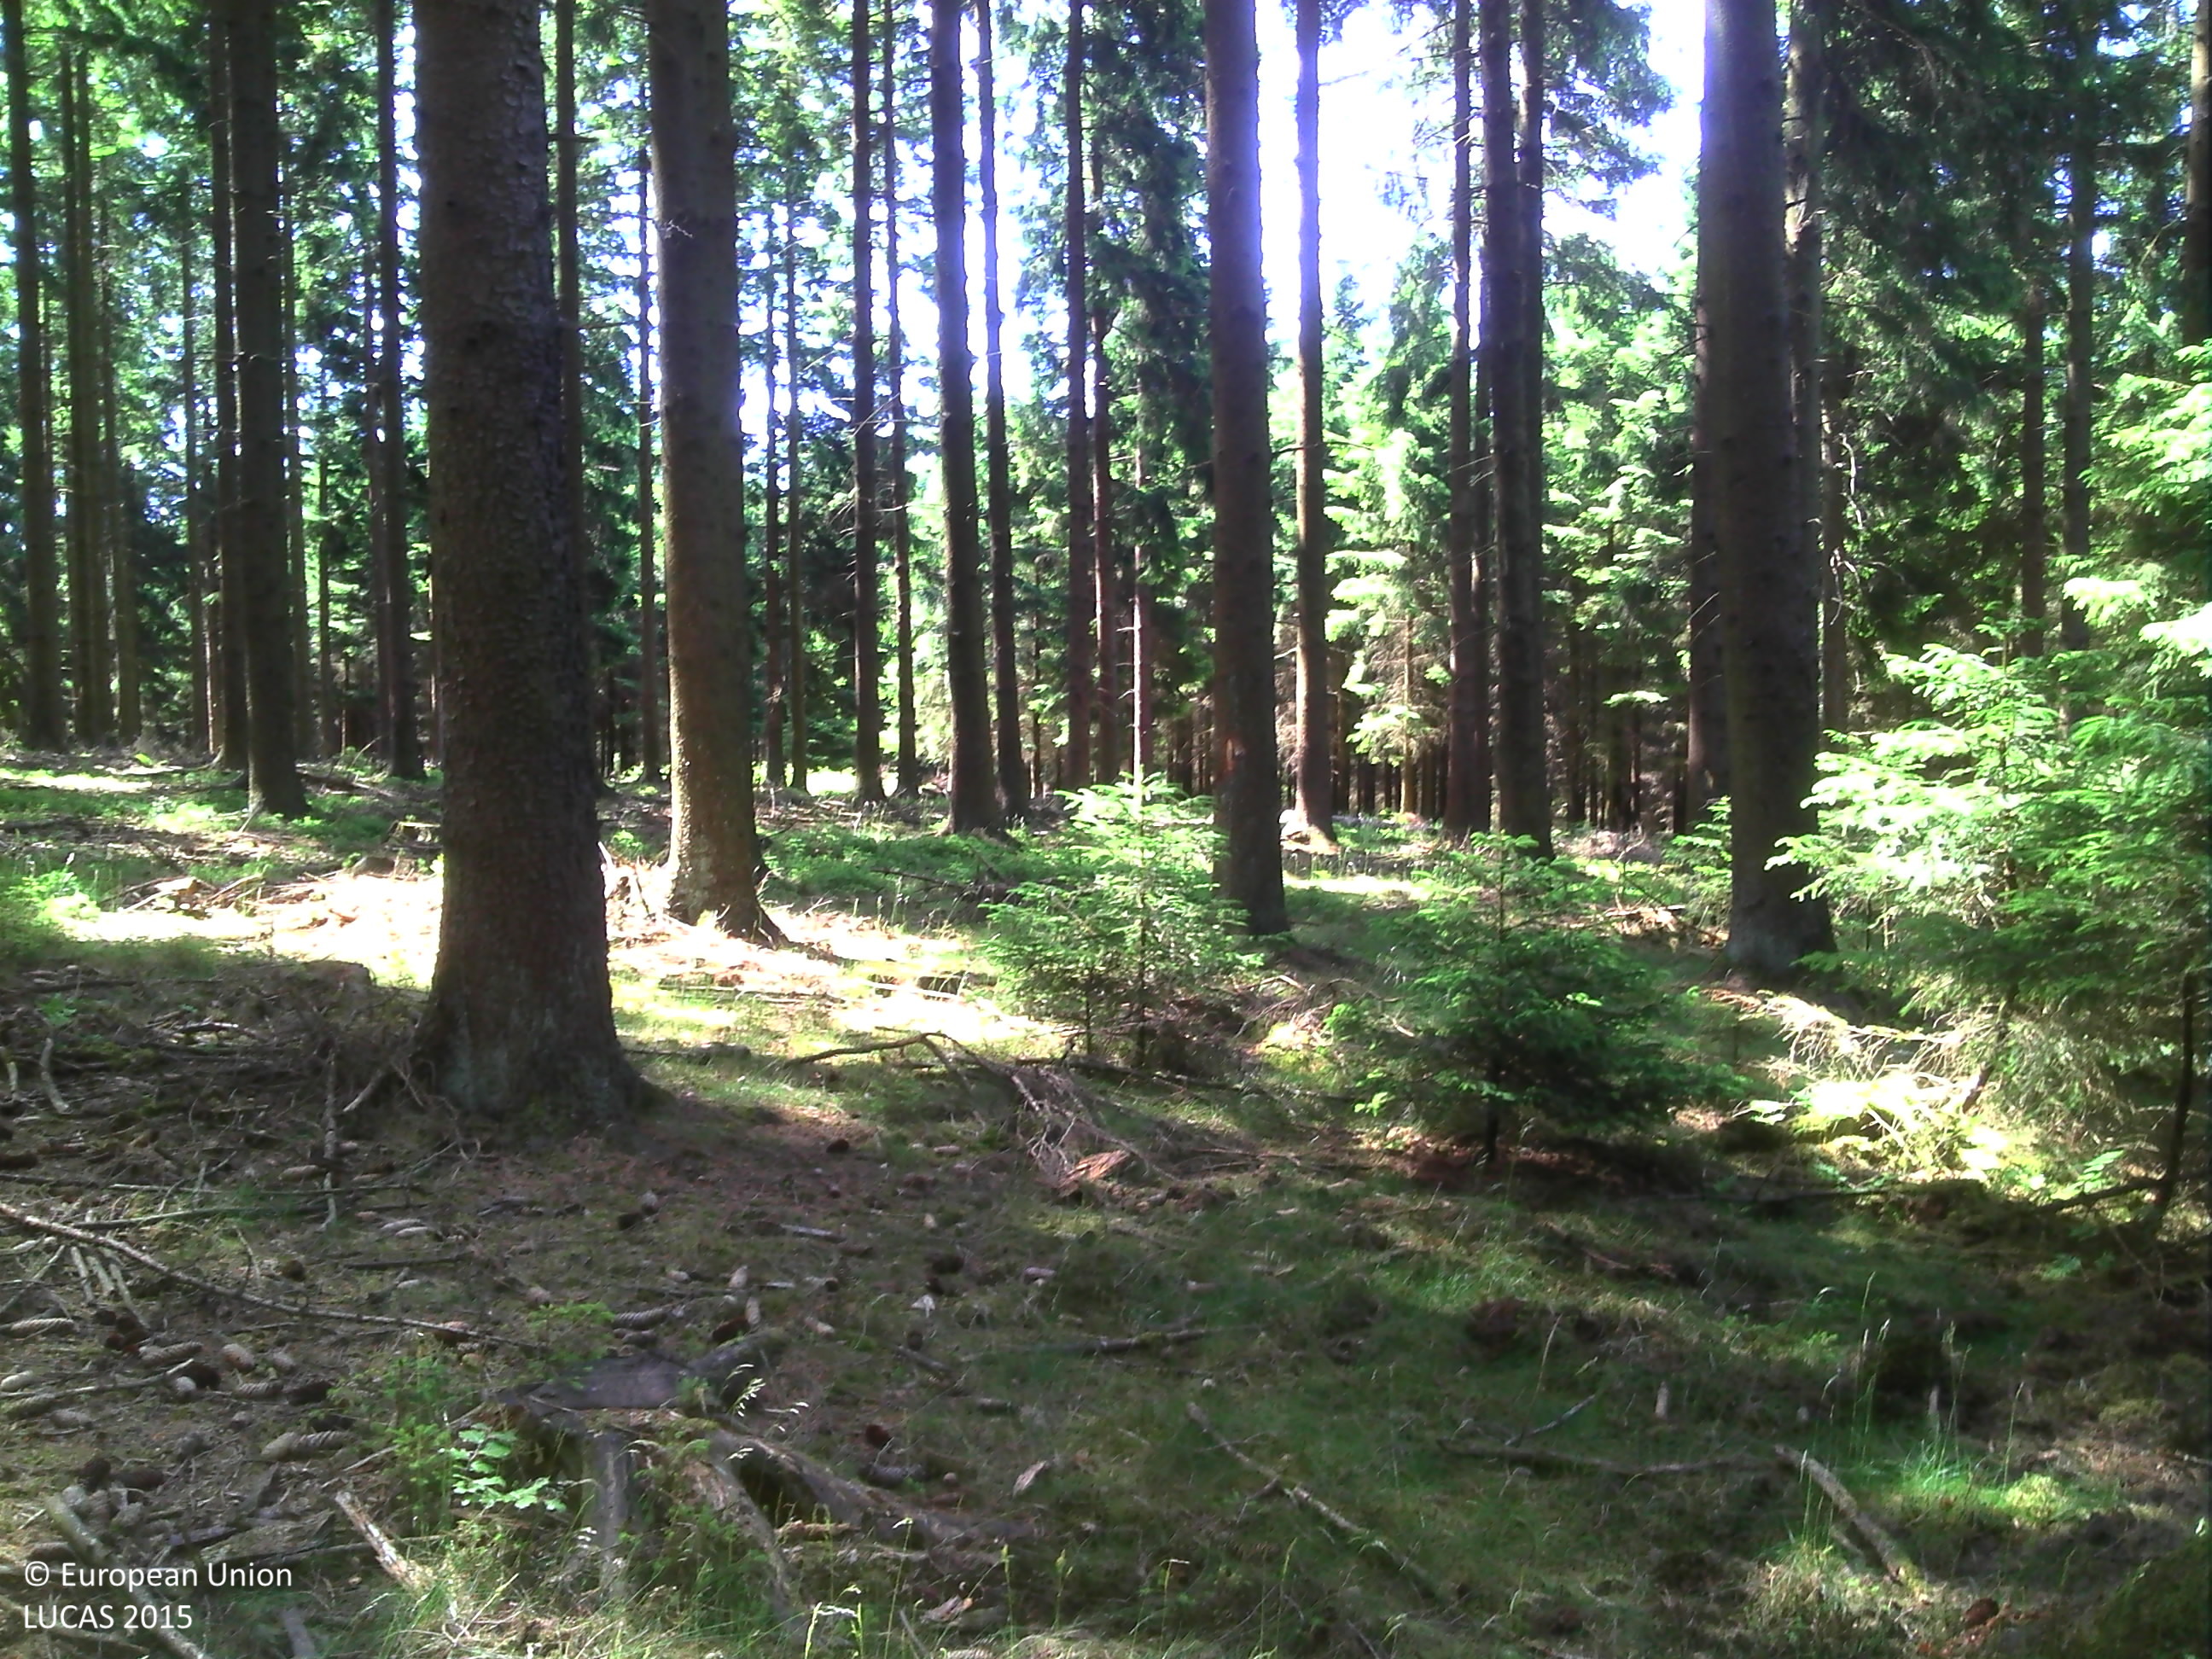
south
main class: Woodland
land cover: Spruce dominated coniferous woodland
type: exotic forest
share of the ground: > 75 %
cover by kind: coniferous forest trees 90 %, herbaceous plants 5 %, lichens and mosses 5 %
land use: Forestry
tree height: > 5 m
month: June
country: BE
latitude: 50.4296
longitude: 5.7614
